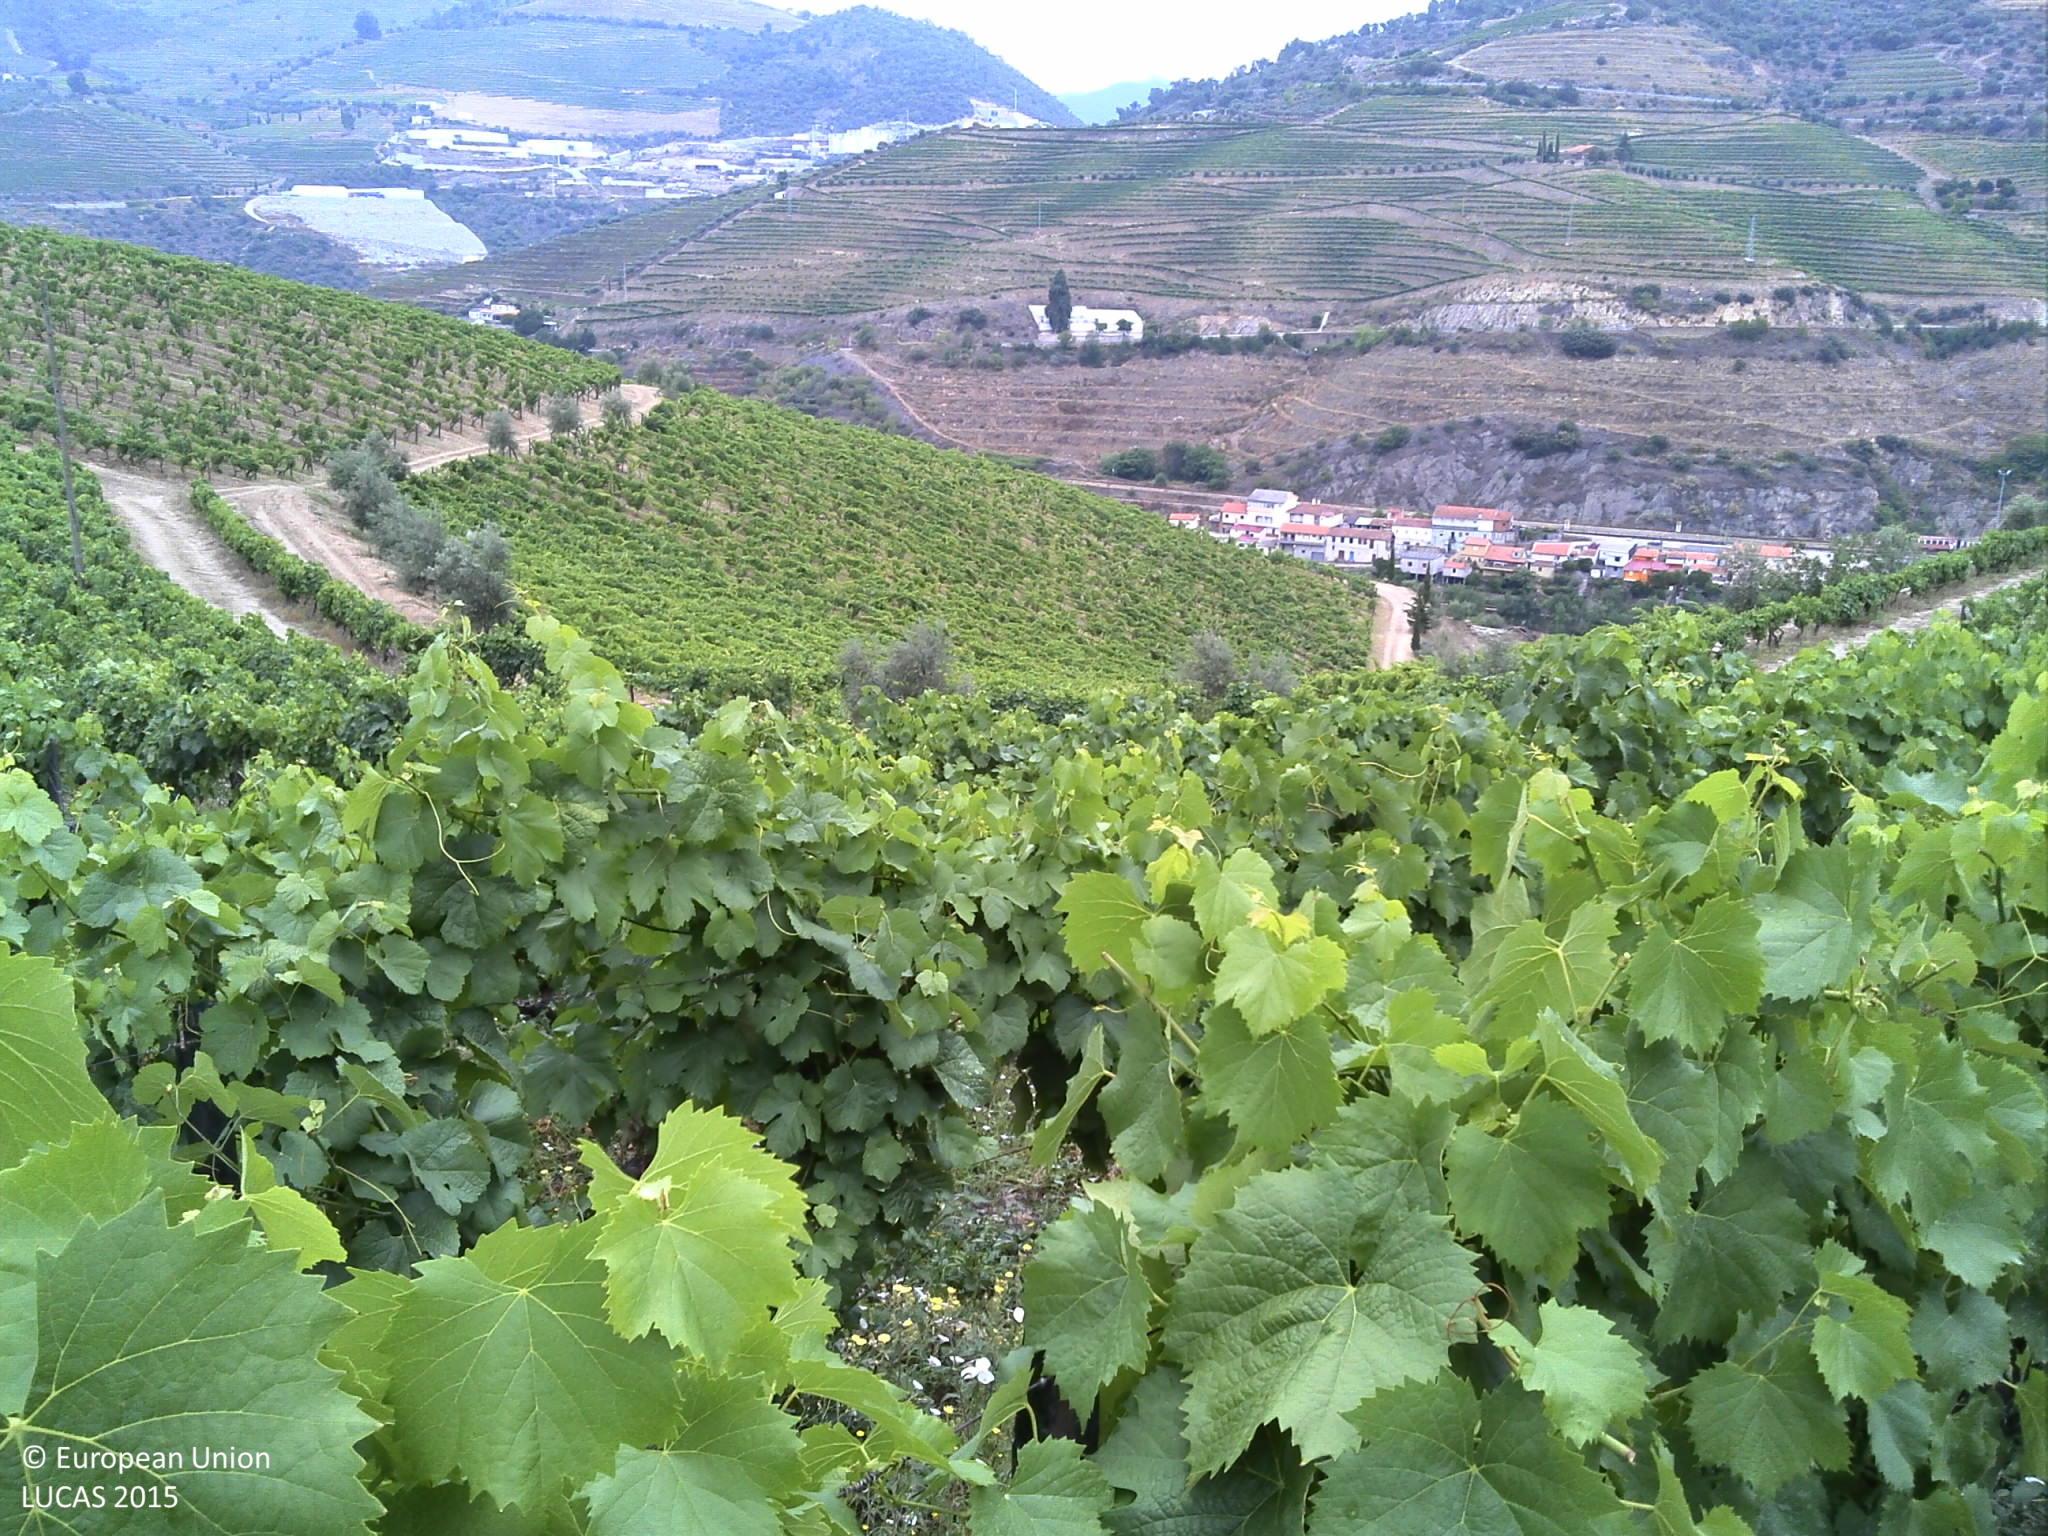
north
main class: Cropland
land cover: Vineyards
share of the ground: 10 - 25 %
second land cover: Spontaneously vegetated surfaces
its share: 50 - 75 %
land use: Agriculture (excluding fallow land and kitchen gardens)
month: June
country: PT
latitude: 41.2037
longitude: -7.4242
